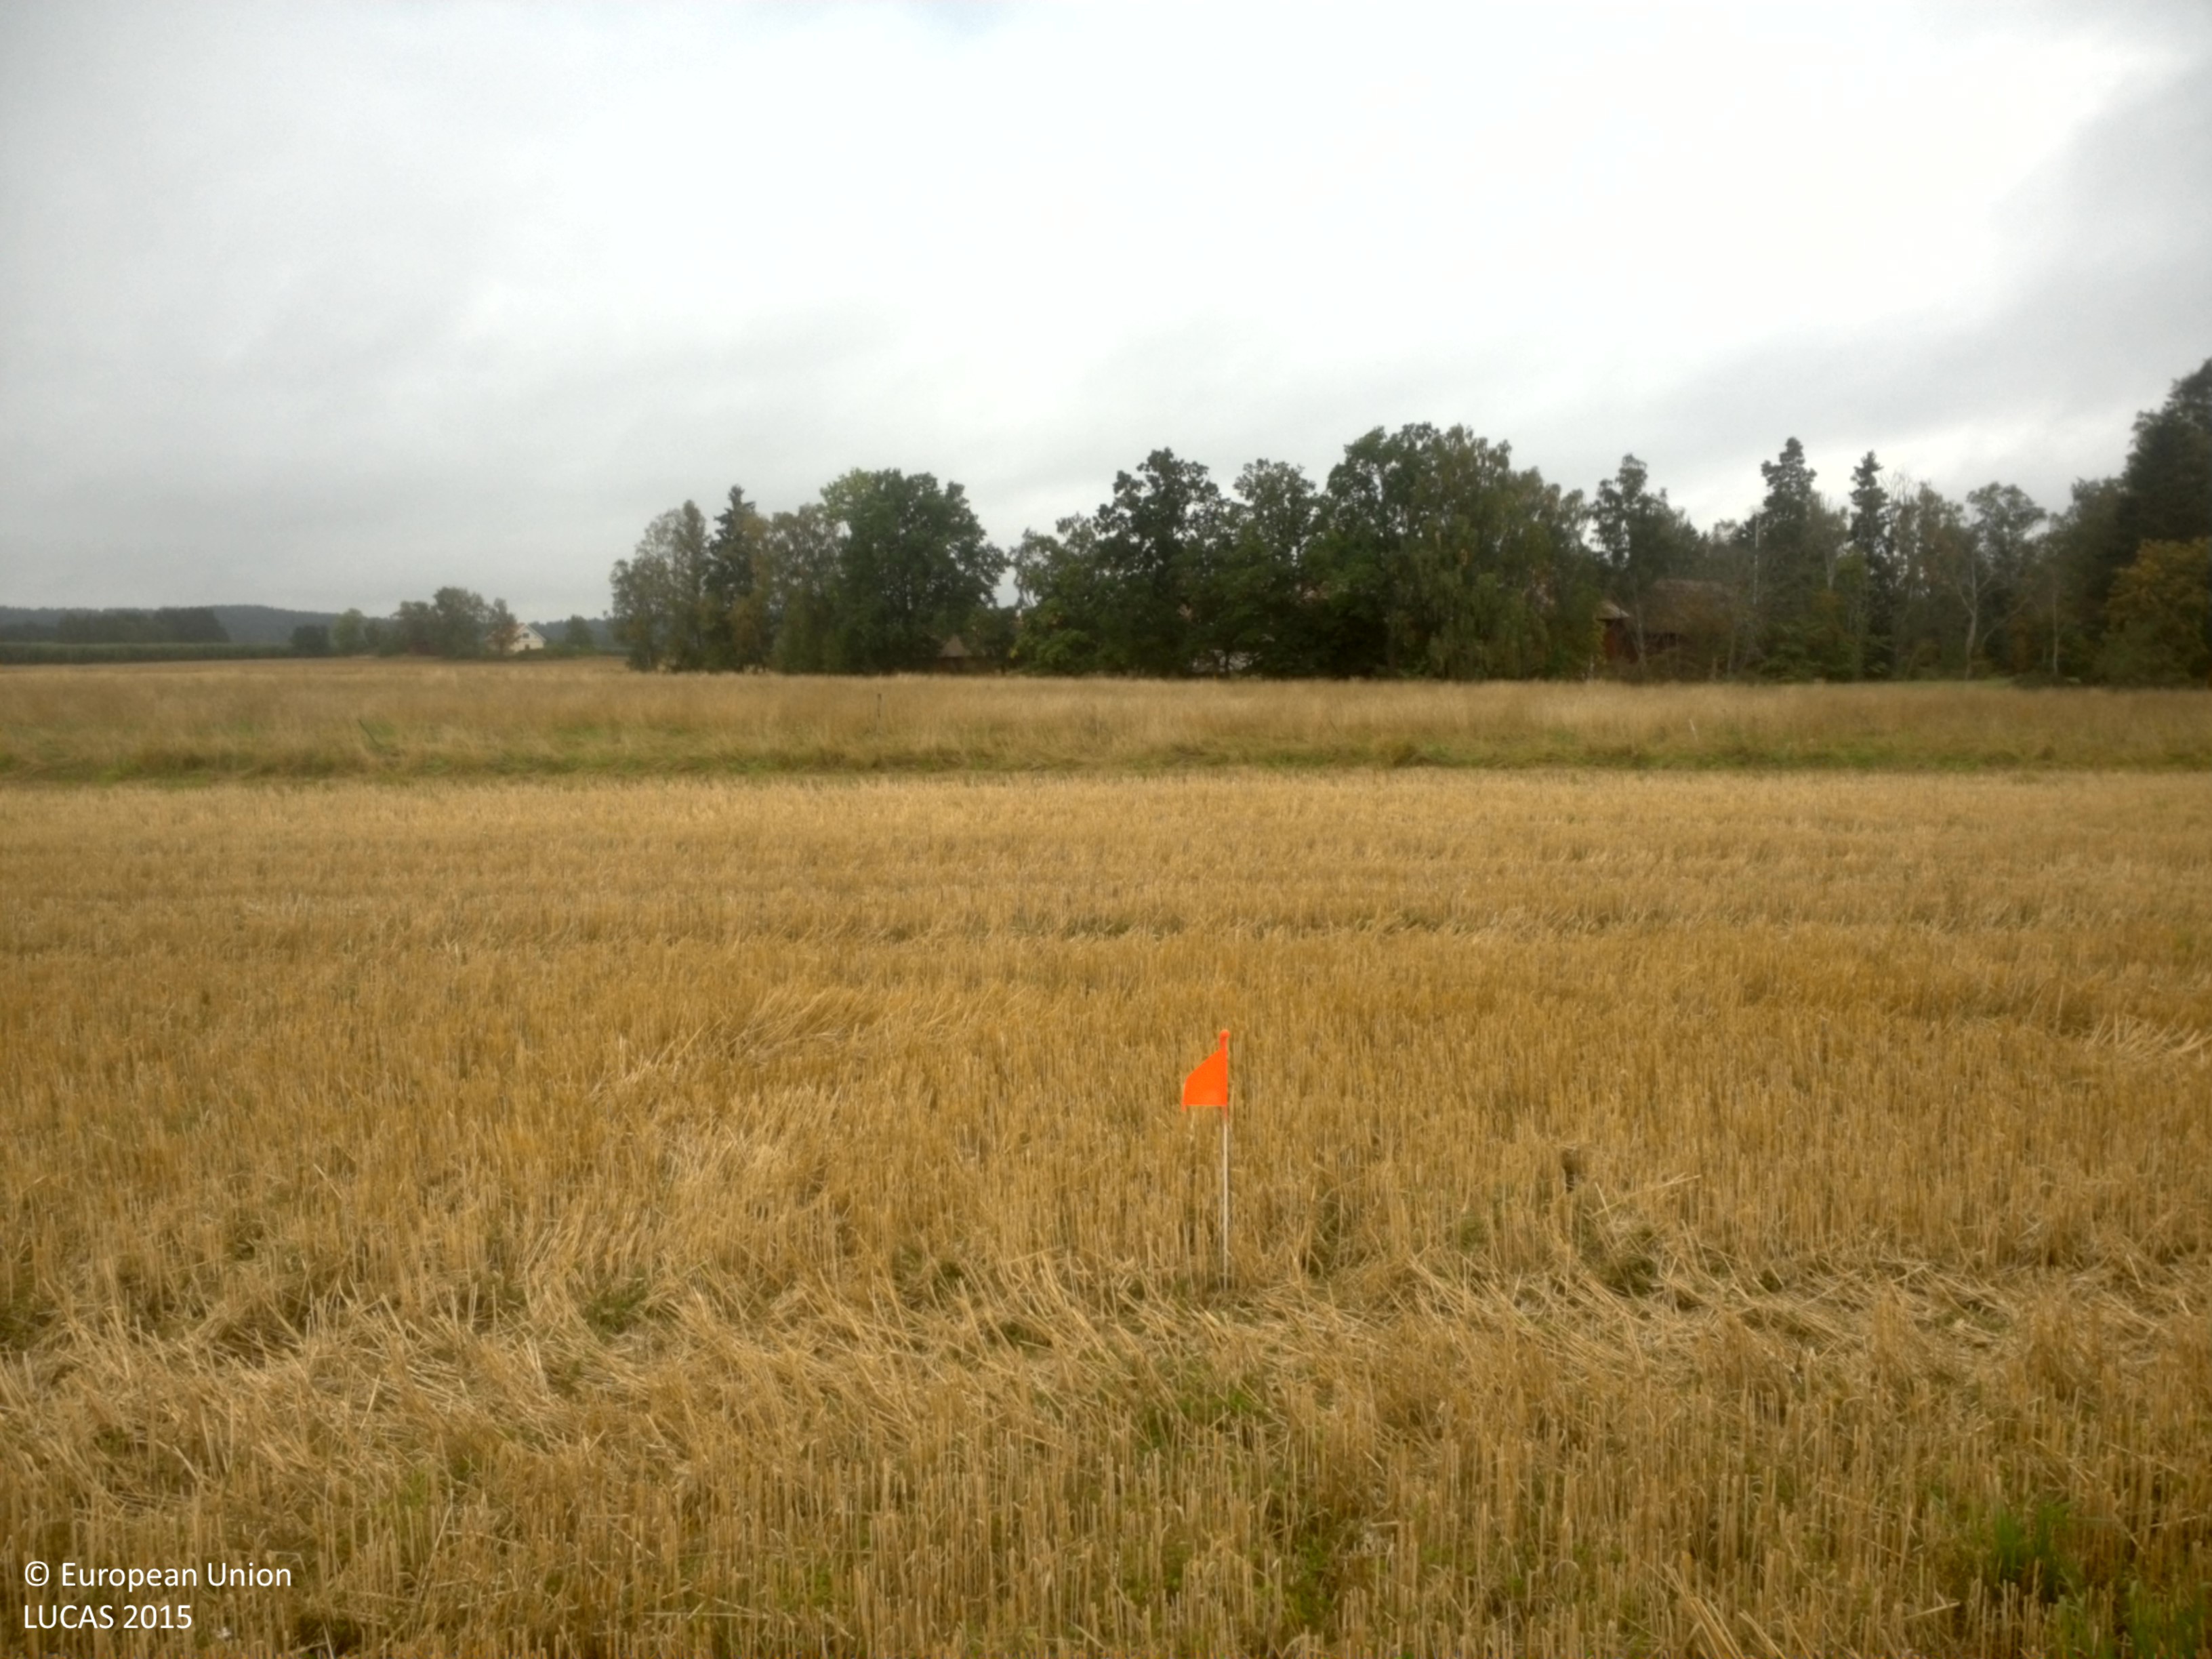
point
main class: Cropland
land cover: Common wheat
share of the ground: > 75 %
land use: Agriculture (excluding fallow land and kitchen gardens)
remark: Harvested field
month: September
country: SE
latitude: 59.4193
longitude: 15.6129
